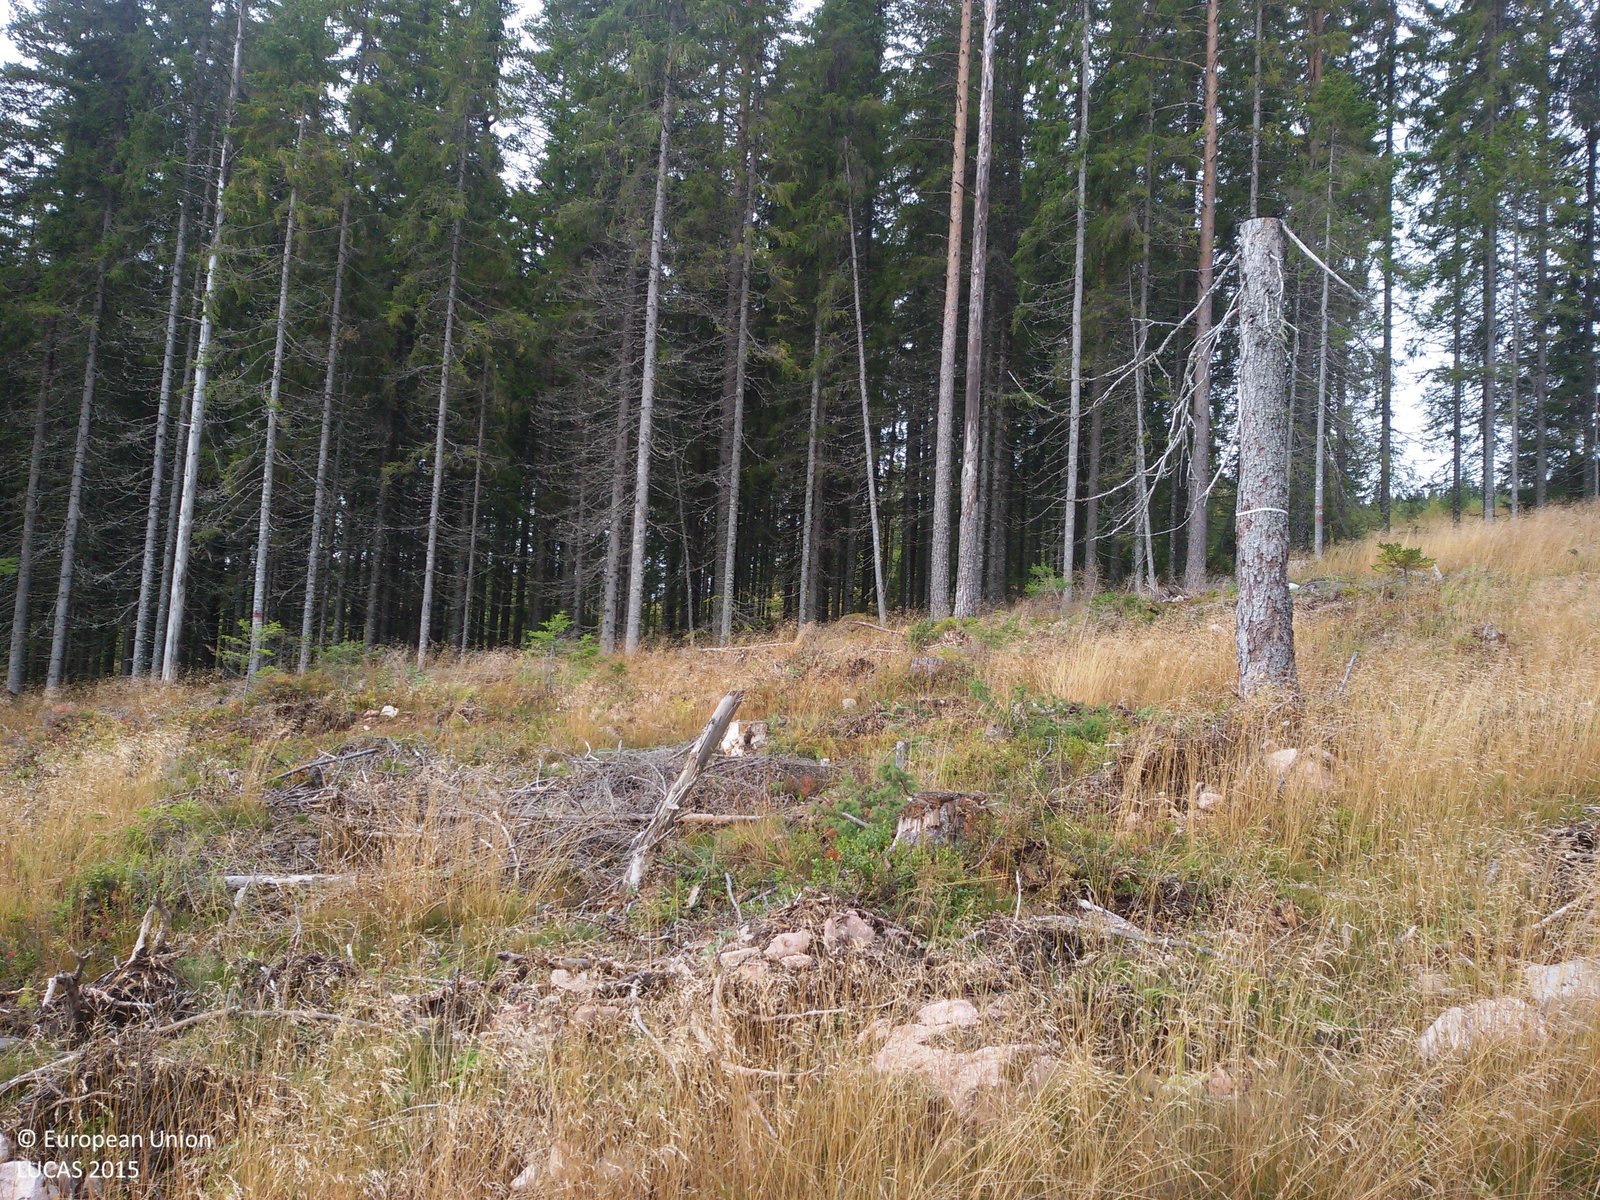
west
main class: Woodland
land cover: Spruce dominated coniferous woodland
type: boreal forest
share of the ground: < 10 %
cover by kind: herbaceous plants 70 %, unconsolidated bare surface 15 %, coniferous forest trees 10 %, lichens and mosses 5 %
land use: Forestry
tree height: < 5 m
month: September
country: SE
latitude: 60.9440
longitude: 14.3248
